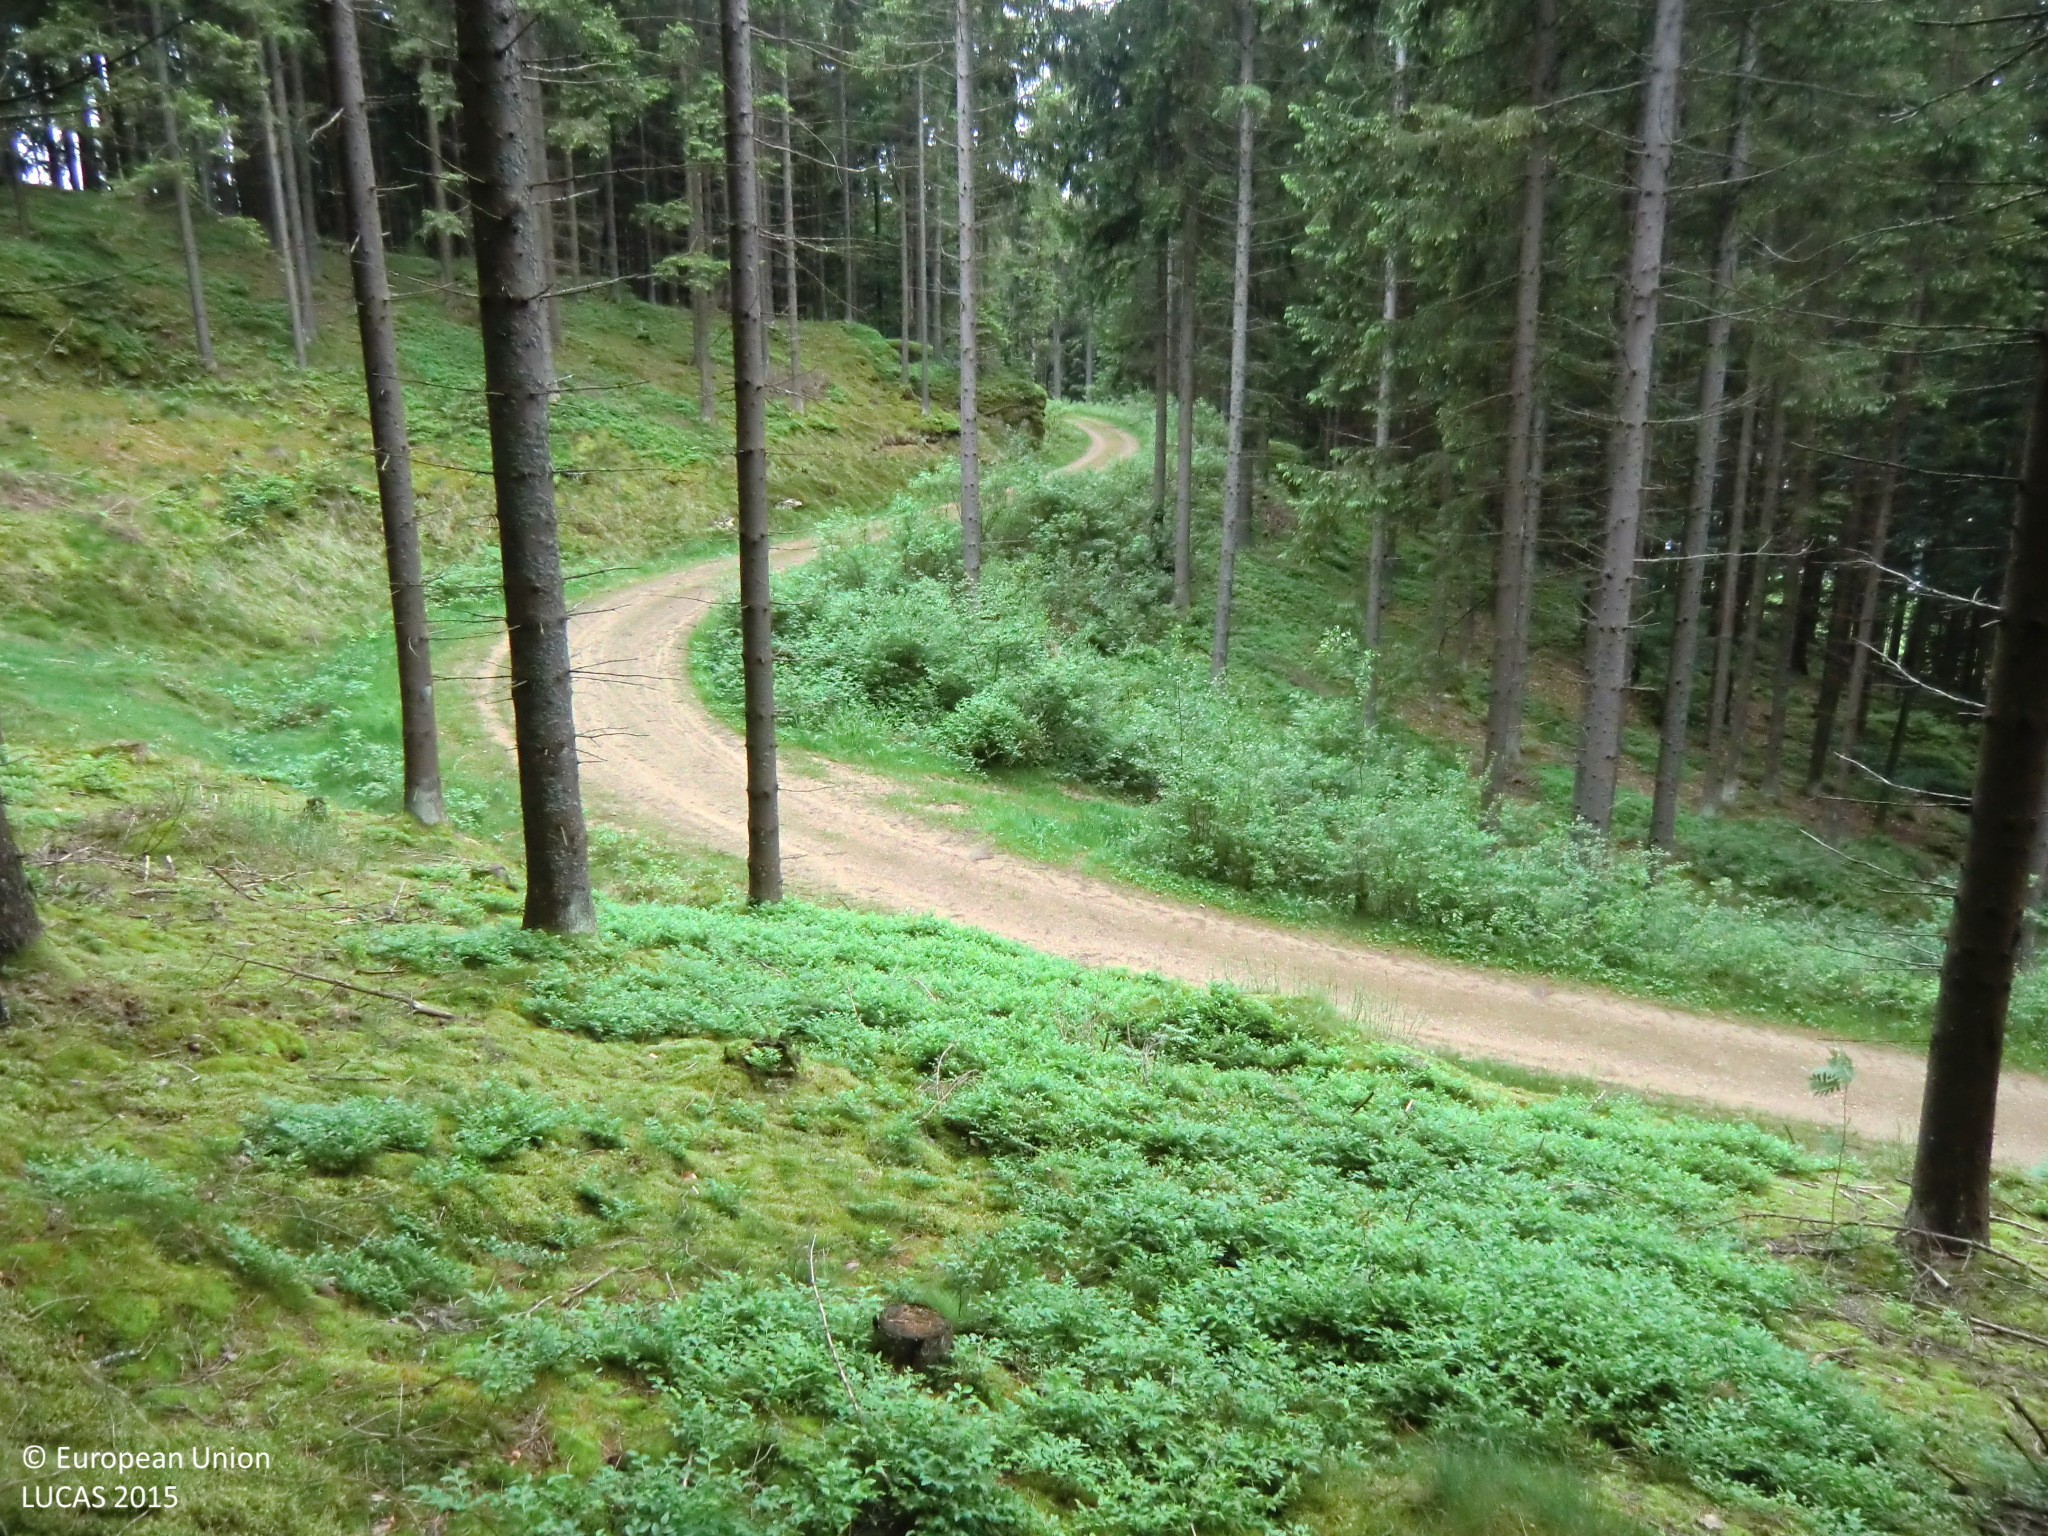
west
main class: Woodland
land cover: Spruce dominated coniferous woodland
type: hemiboreal forest and nemoral coniferous forest and mixed broadleaved-coniferous forest
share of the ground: > 75 %
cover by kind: coniferous forest trees 75 %, unconsolidated bare surface 15 %, shrubs 5 %, herbaceous plants 5 %
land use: Forestry
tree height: > 5 m
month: May
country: AT
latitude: 48.4052
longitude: 14.8507
